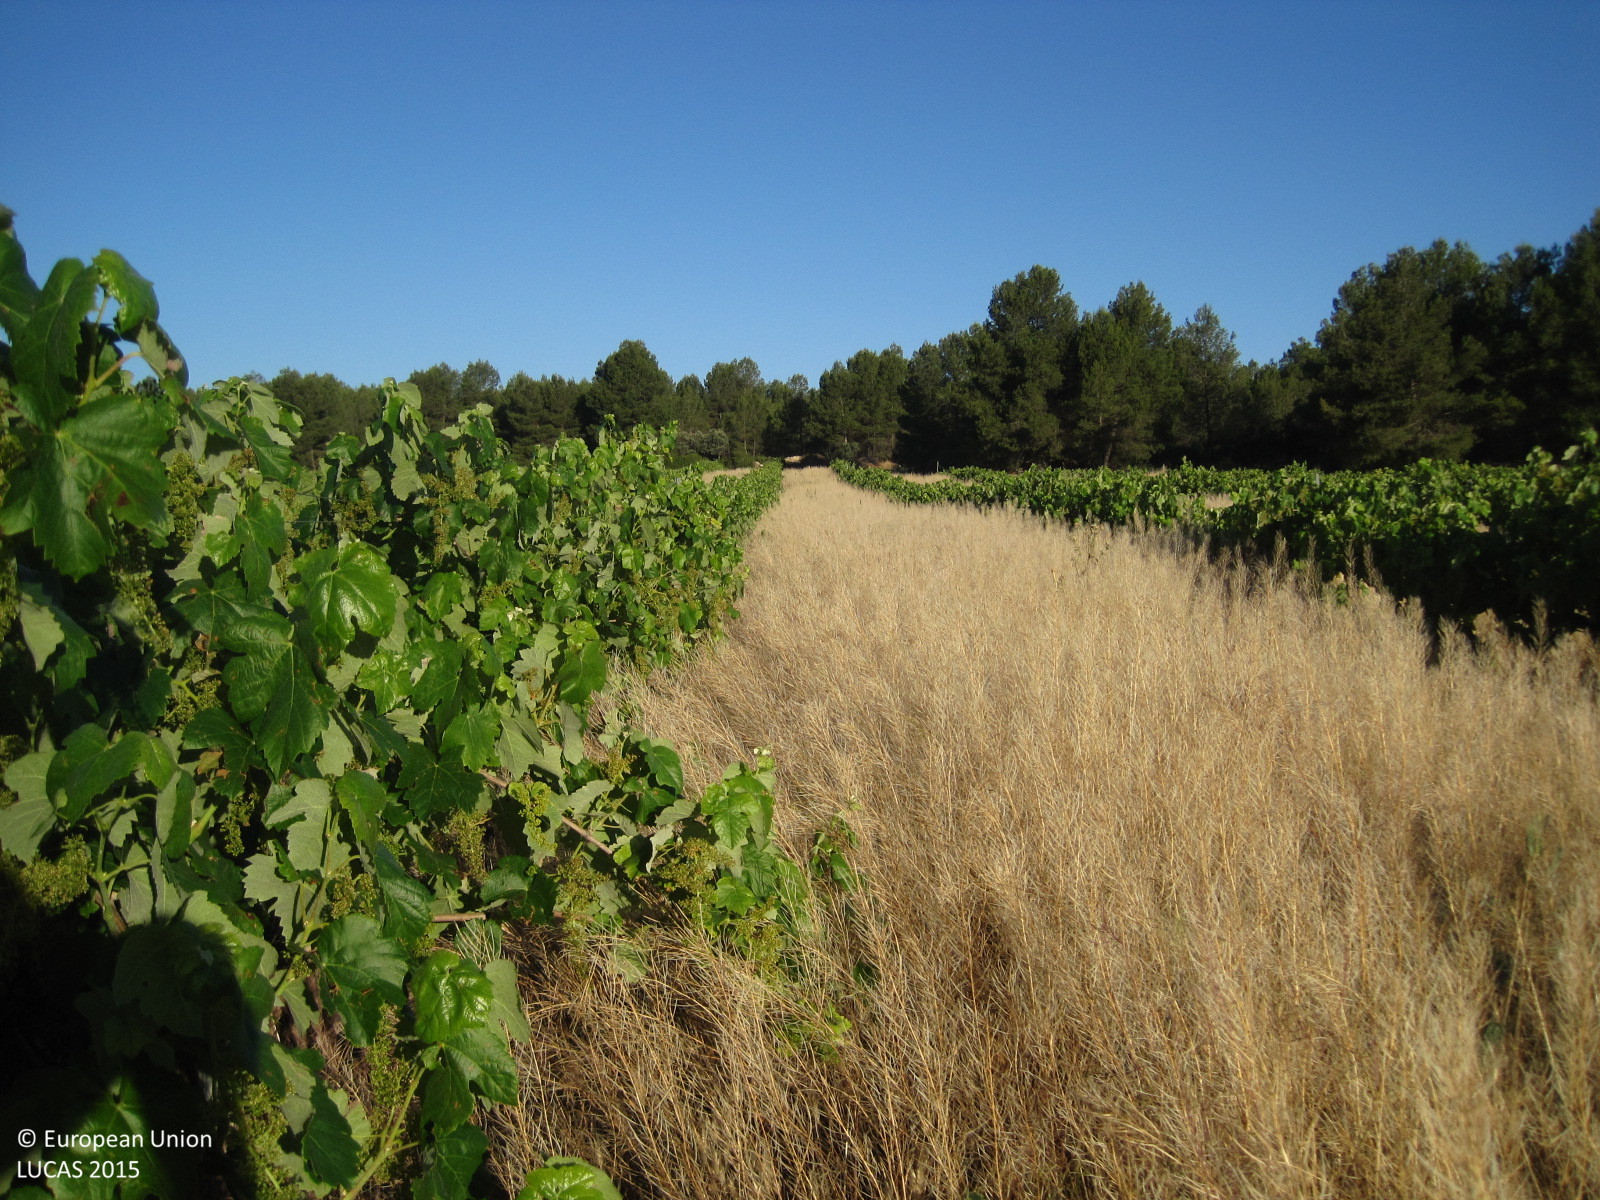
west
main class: Cropland
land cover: Vineyards
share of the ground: 10 - 25 %
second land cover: Spontaneously vegetated surfaces
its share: > 75 %
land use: Agriculture (excluding fallow land and kitchen gardens)
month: June
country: ES
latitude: 39.3609
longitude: -1.1067
